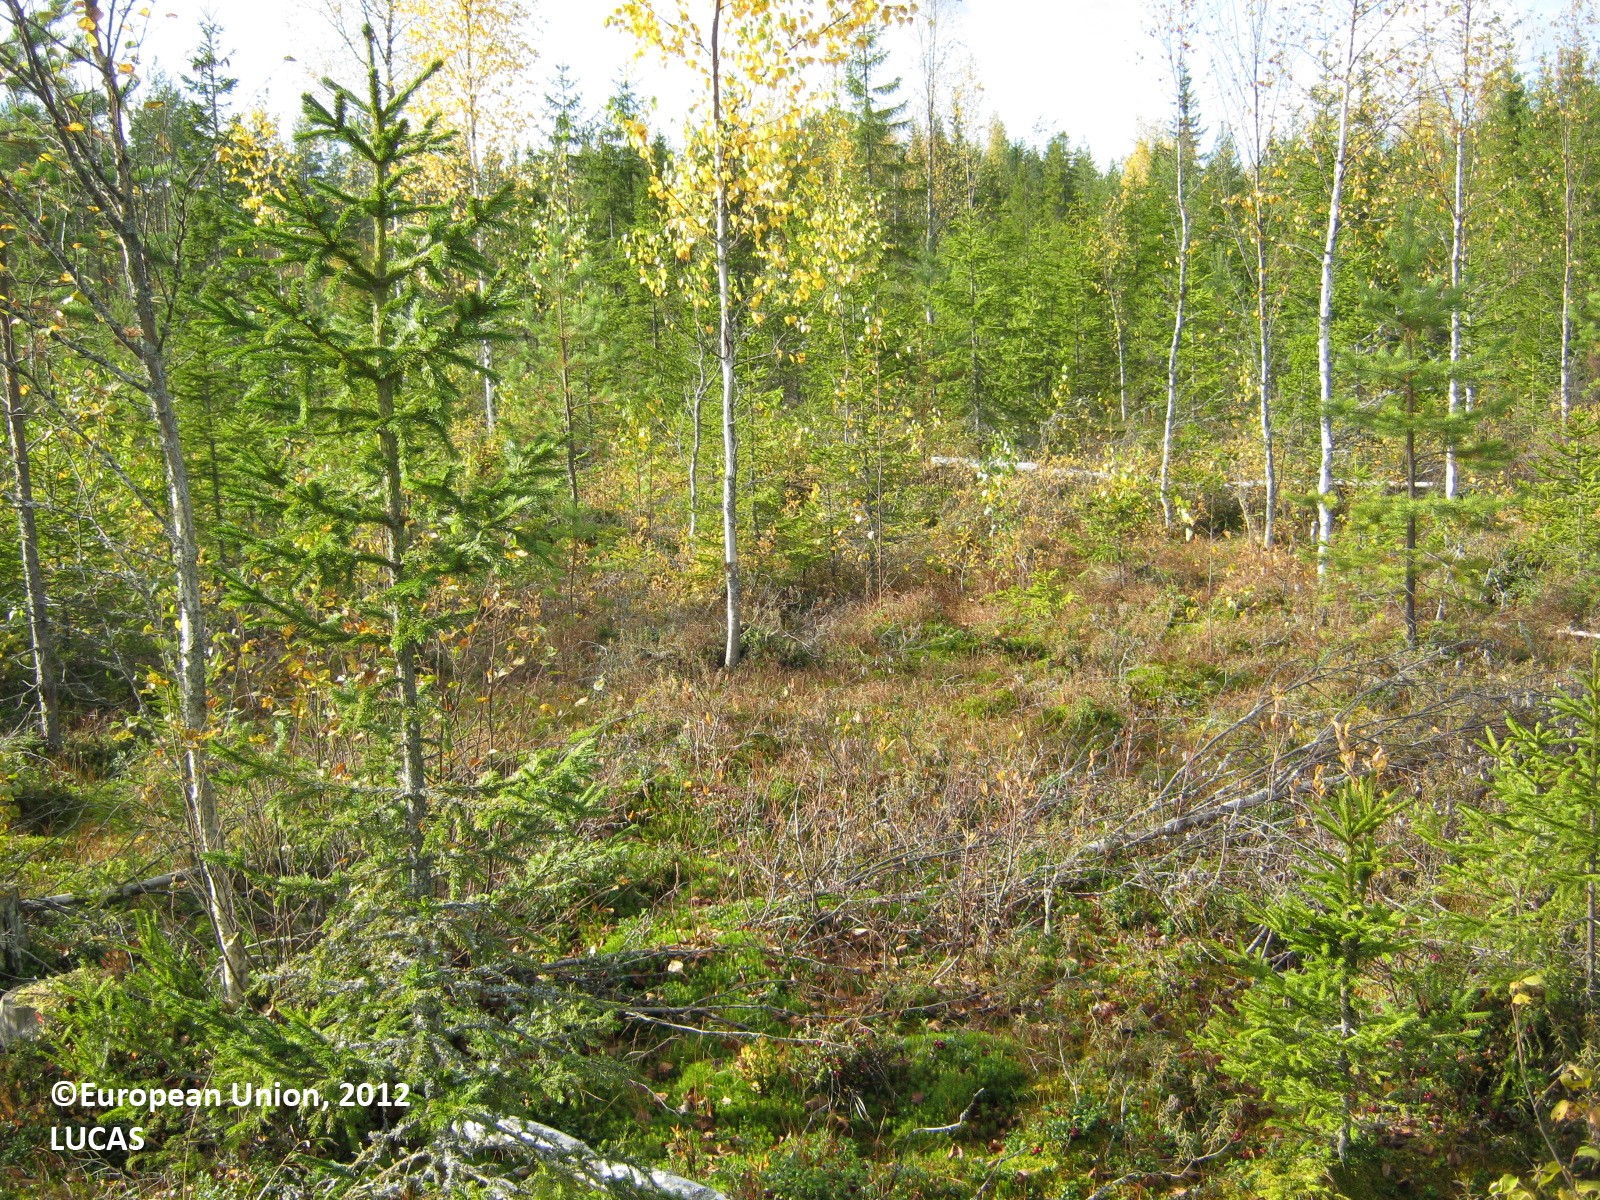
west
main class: Woodland
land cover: Other mixed woodland
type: boreal forest
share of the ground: 50 - 75 %
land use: Forestry
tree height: < 5 m
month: September
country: FI
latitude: 62.2919
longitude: 28.8991
